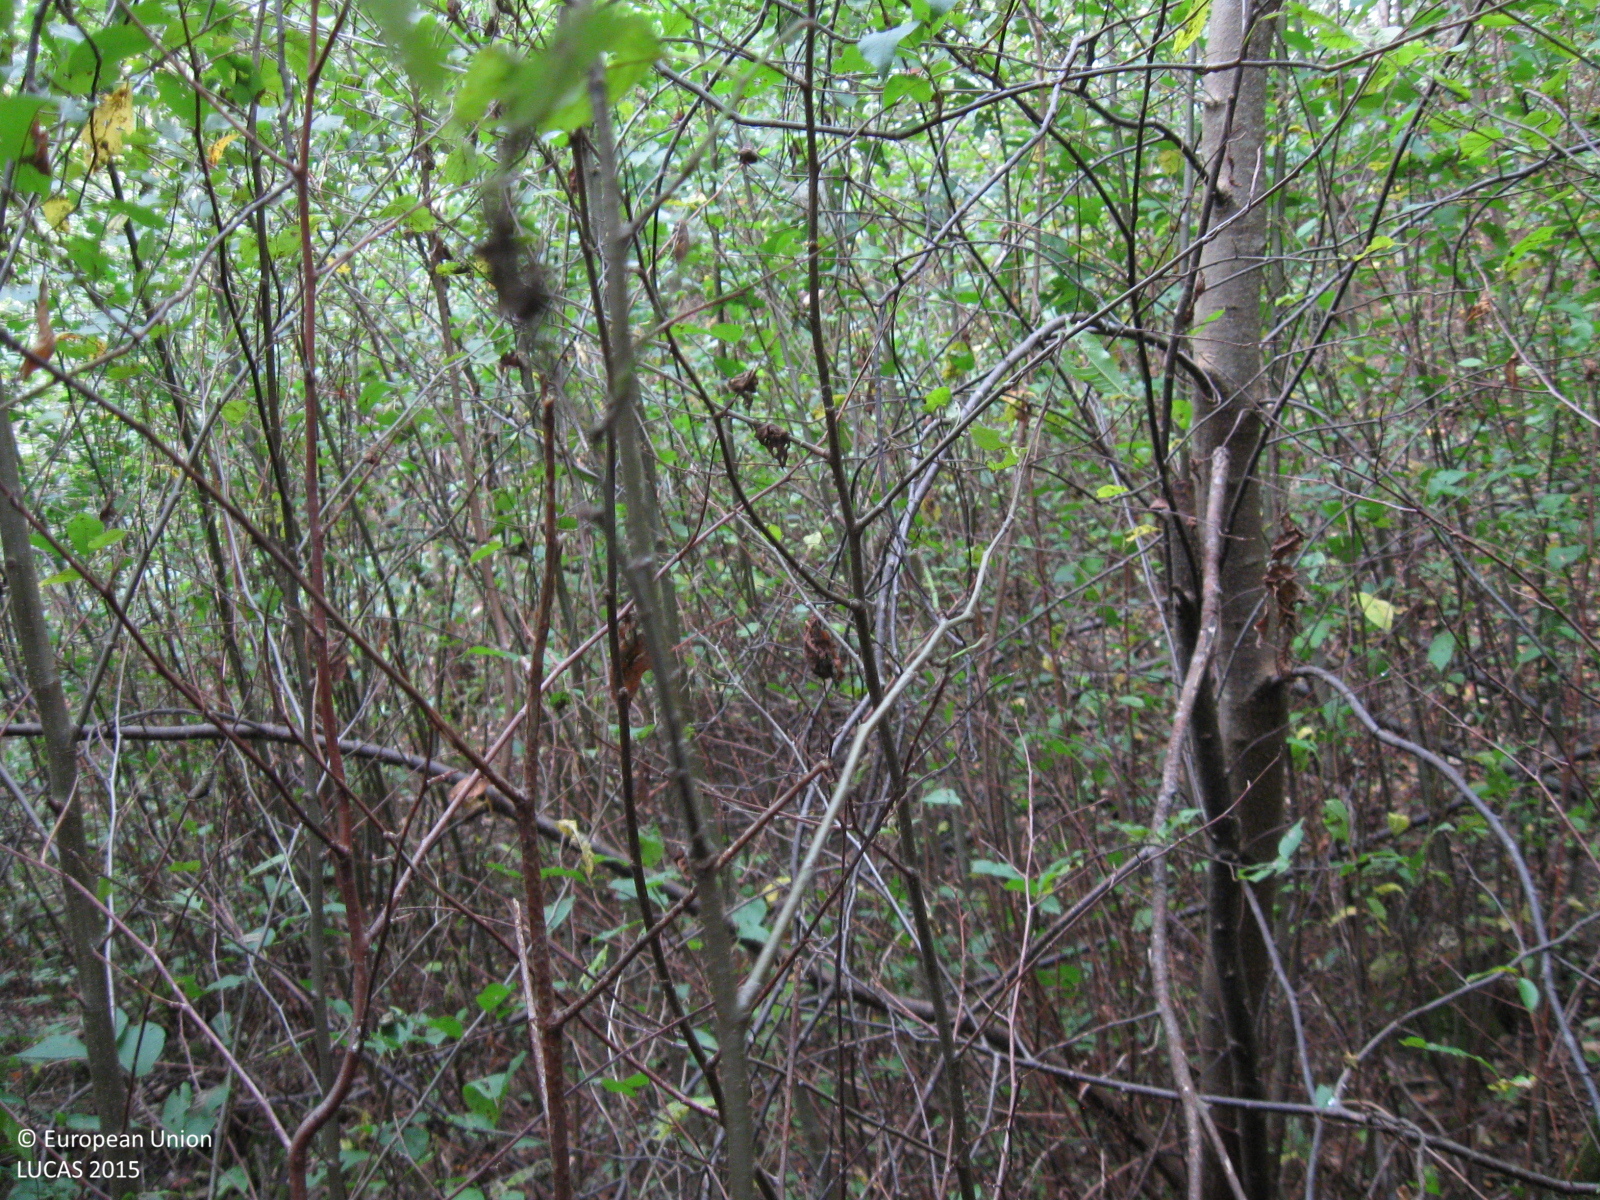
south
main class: Woodland
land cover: Broadleaved woodland
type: non-riverine alder, birch or aspen forest
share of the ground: > 75 %
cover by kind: broadleaved forest trees 90 %, herbaceous plants 10 %
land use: Forestry
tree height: > 5 m
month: September
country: LT
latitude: 55.2753
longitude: 23.4428
